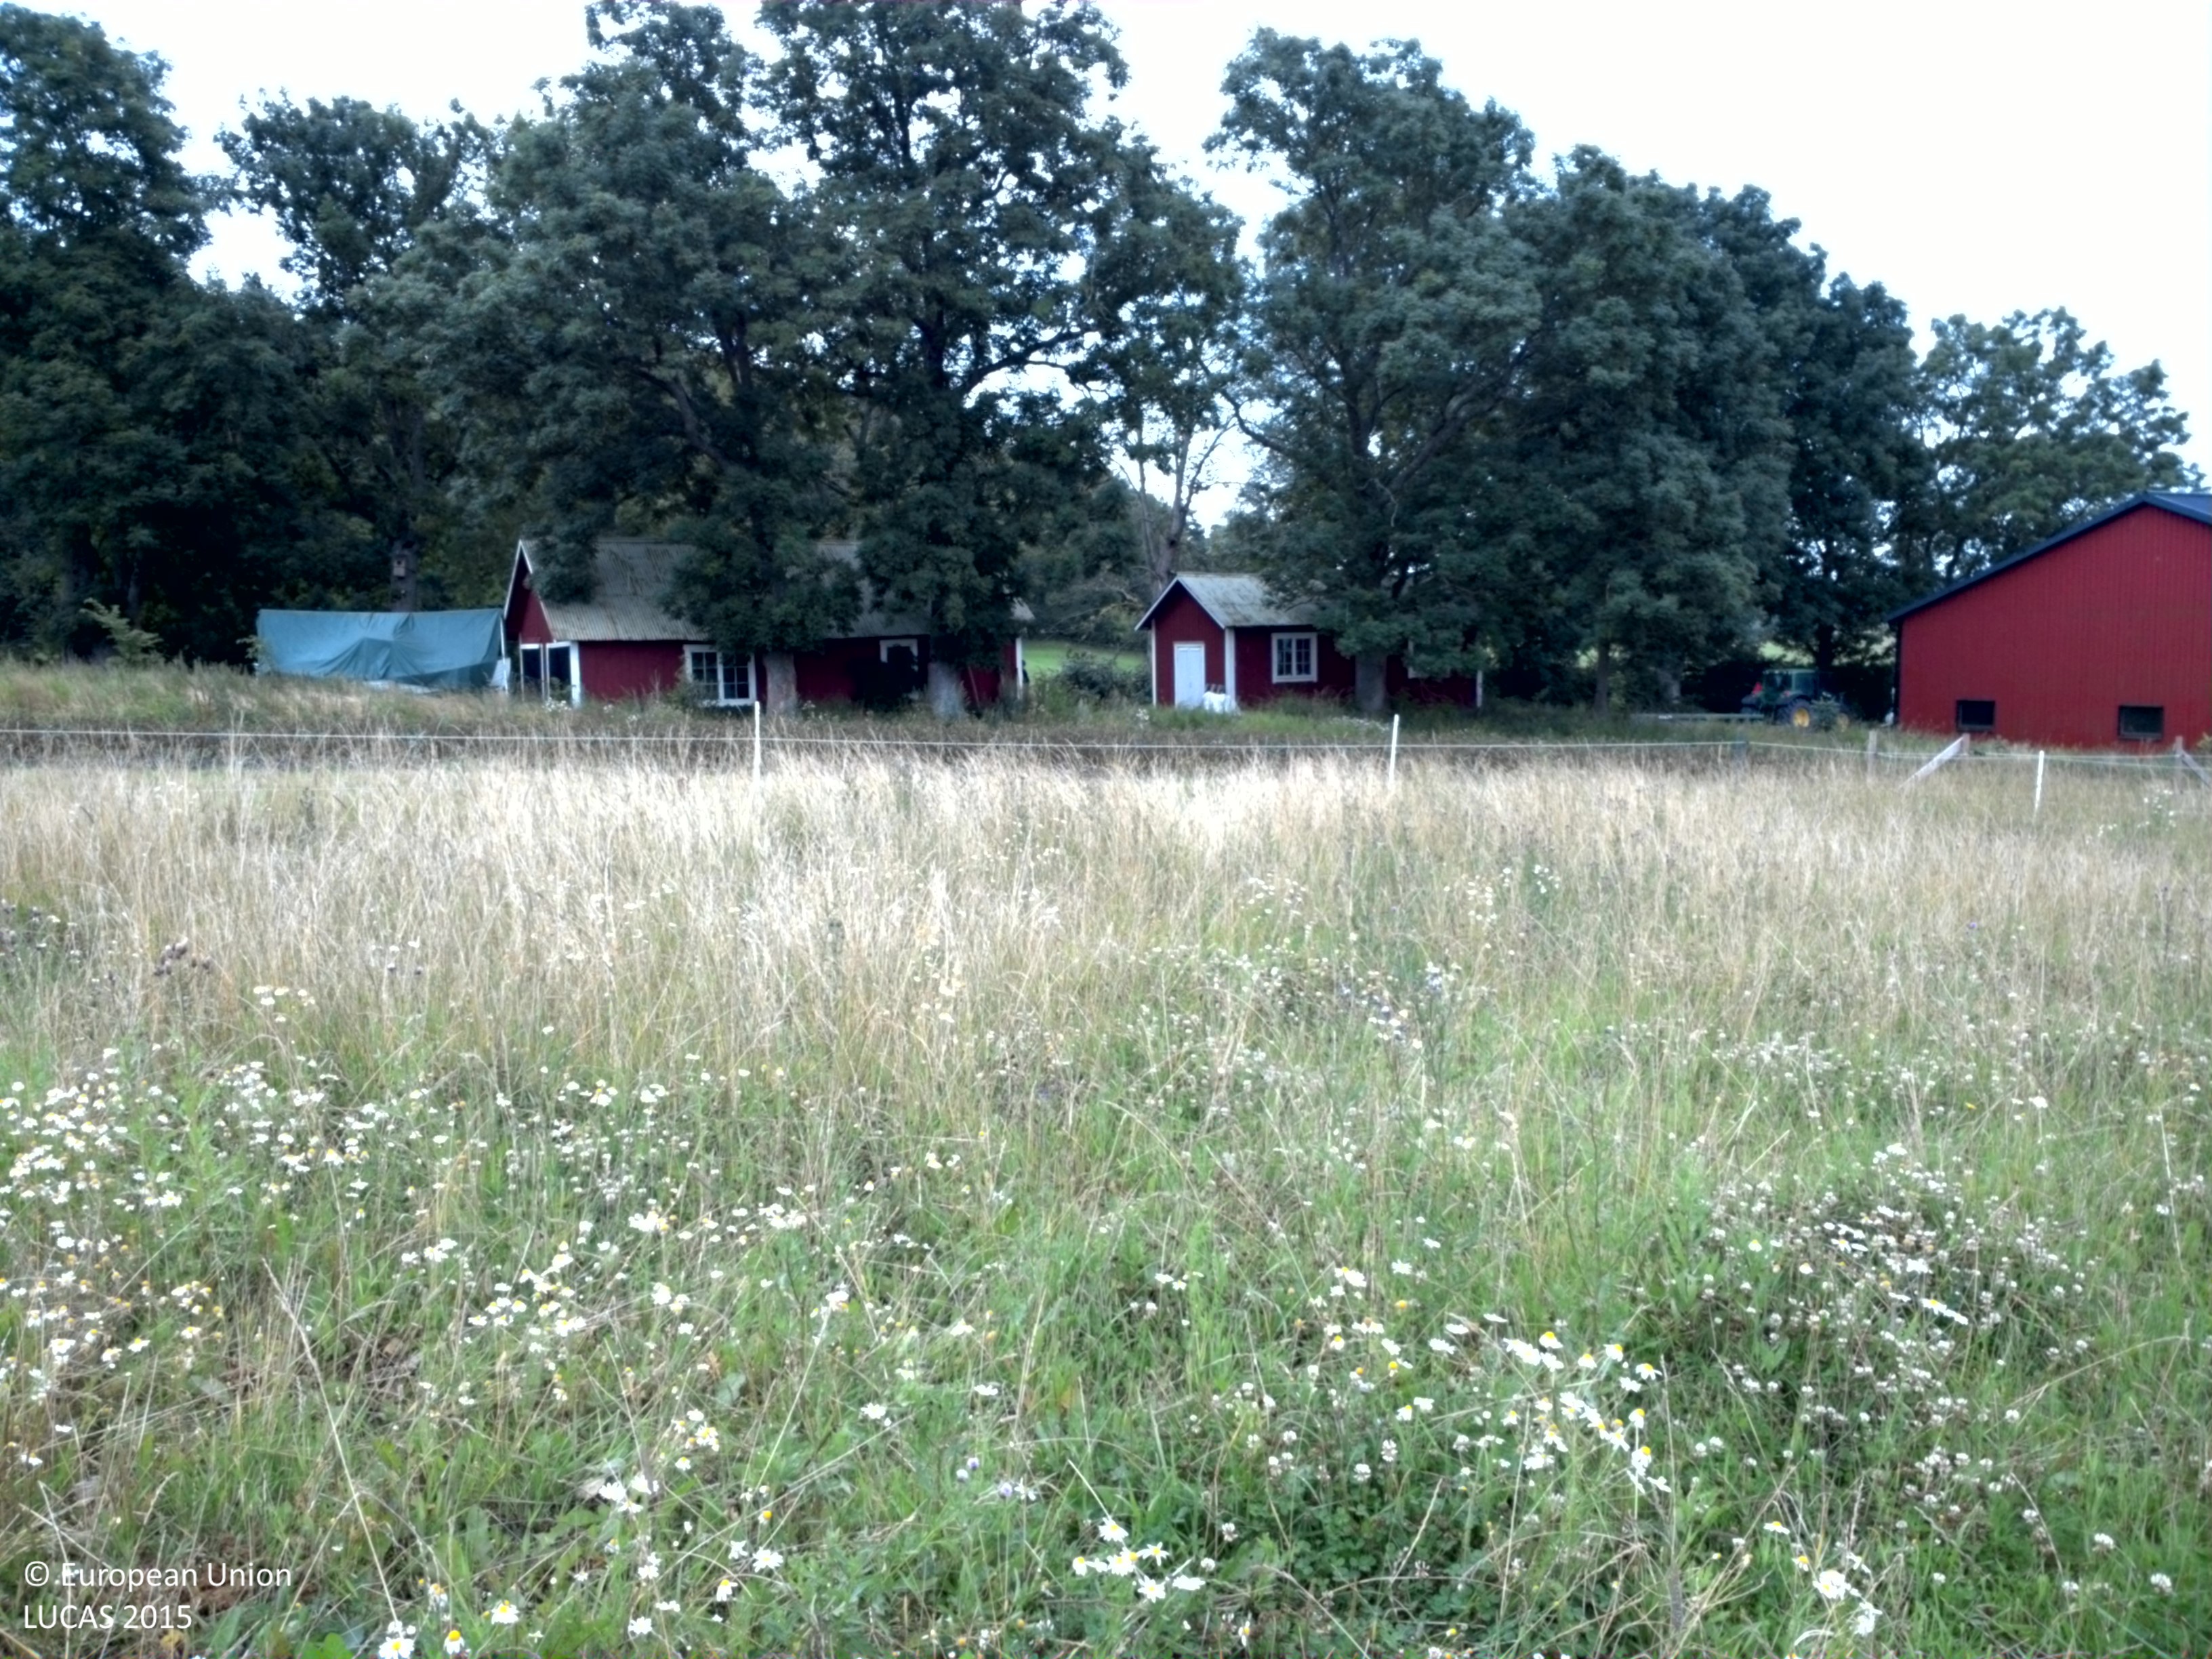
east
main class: Grassland
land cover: Grassland without tree/shrub cover
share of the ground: > 75 %
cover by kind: herbaceous plants 100 %
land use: Agriculture (excluding fallow land and kitchen gardens)
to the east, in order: Grassland without tree/shrub cover; Fences; Grassland without tree/shrub cover; Potatoes; Artificial constructions in urban areas; Grassland without tree/shrub cover; Fences; Ditches and canals; Broadleaved woodland; Spruce dominated mixed woodland; Pine dominated mixed woodland
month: July
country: SE
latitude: 59.4665
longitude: 18.2754
